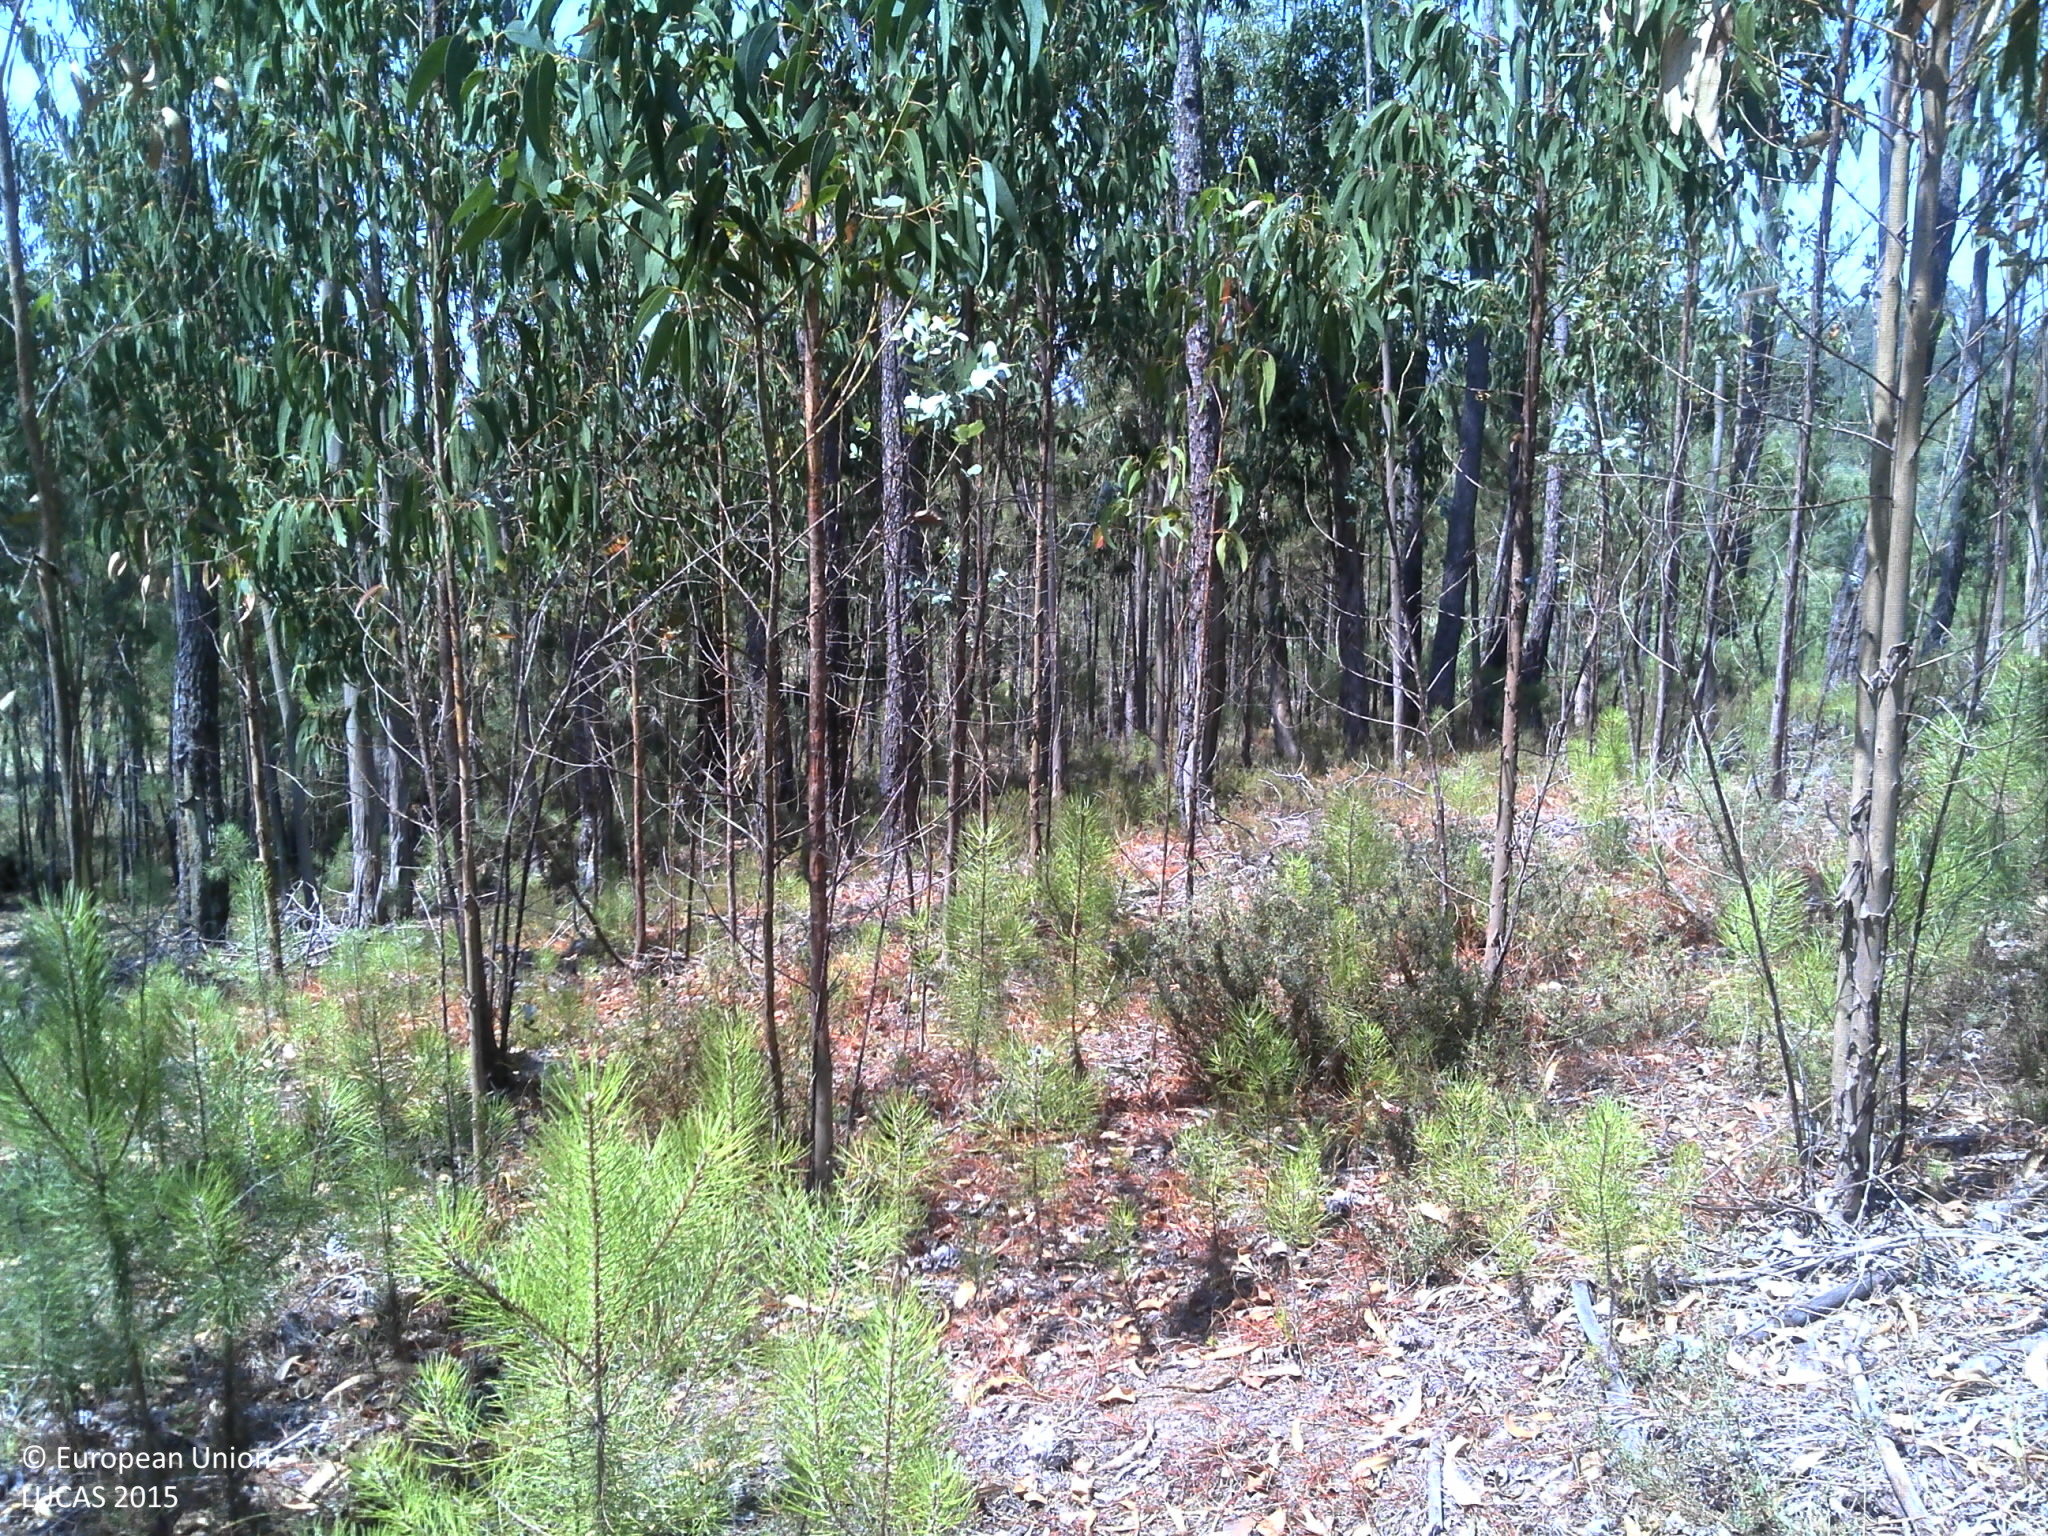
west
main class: Woodland
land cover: Pine dominated mixed woodland
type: coniferous forest of the mediterranean region
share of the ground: 10 - 25 %
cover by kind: shrubs 30 %, unconsolidated bare surface 30 %, coniferous forest trees 20 %, broadleaved forest trees 20 %
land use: Forestry
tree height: > 5 m
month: July
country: PT
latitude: 40.0715
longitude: -8.5523
